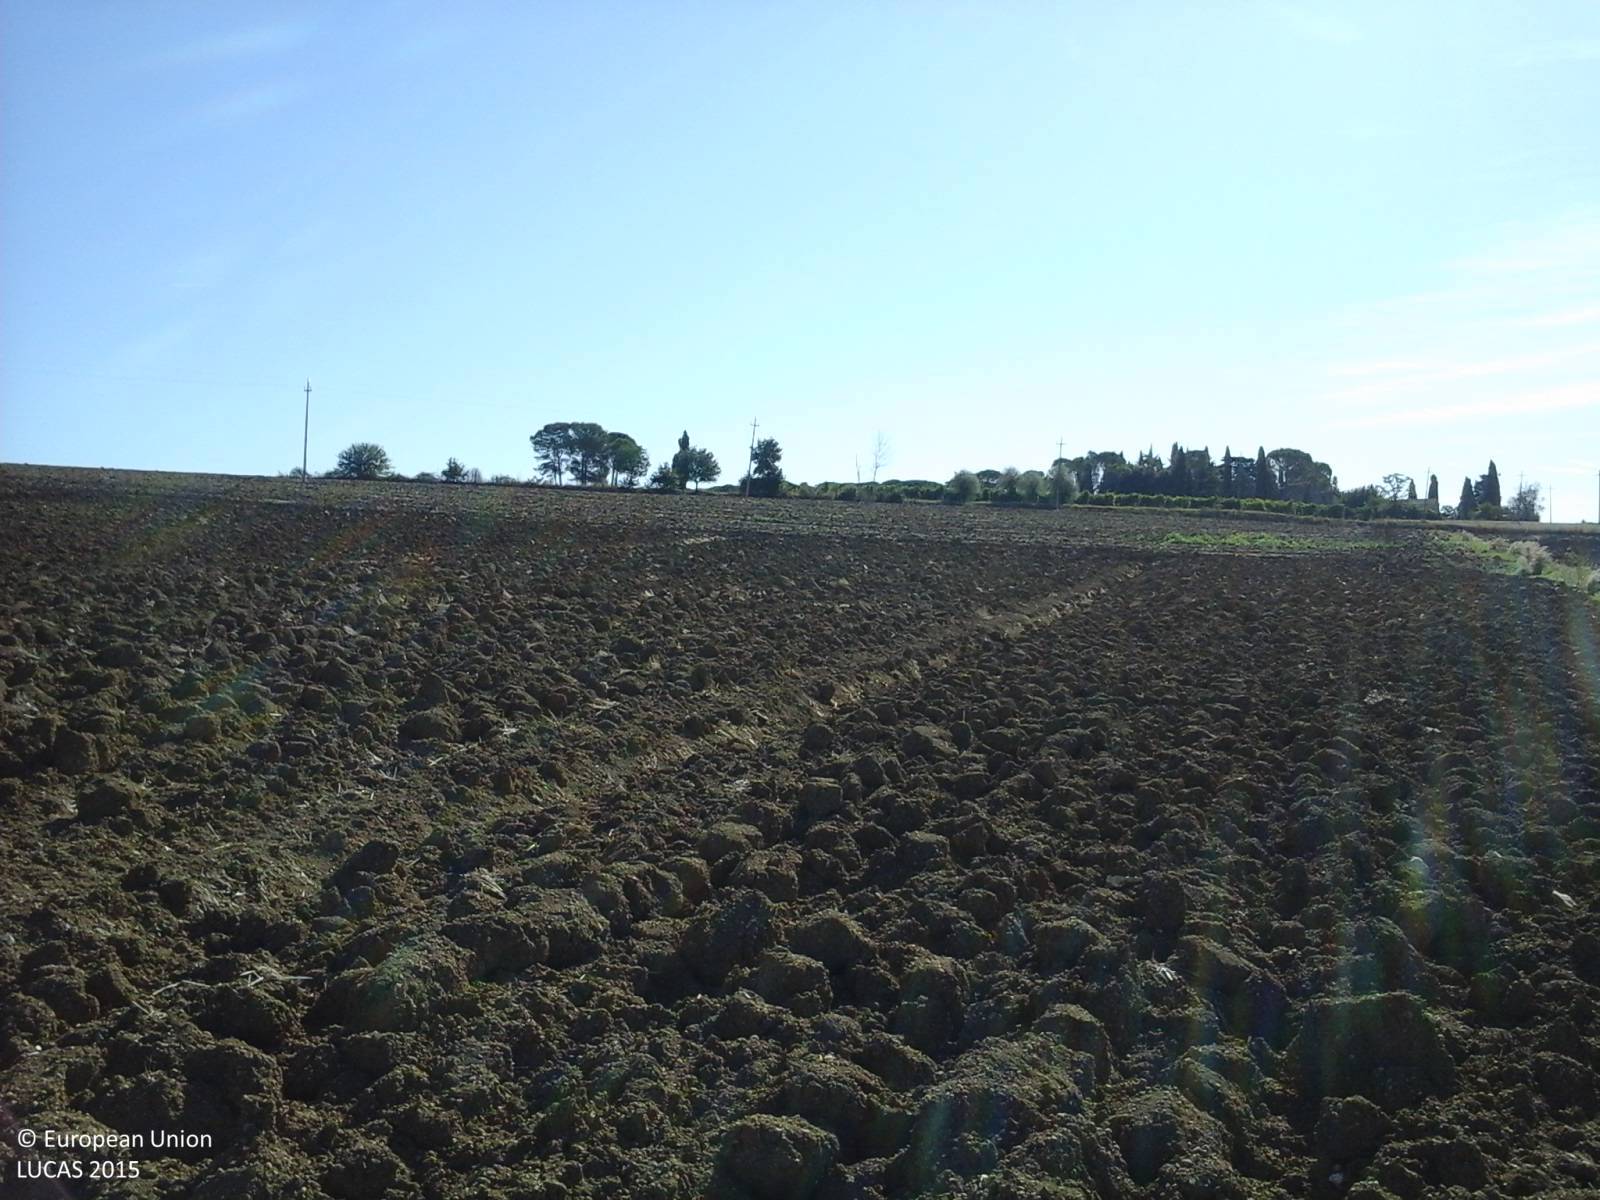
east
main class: Cropland
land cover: Common wheat
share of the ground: < 10 %
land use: Agriculture (excluding fallow land and kitchen gardens)
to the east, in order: Common wheat; Ditches and canals; Common wheat; Electric lines; Common wheat; Grass margins; Other bare soil
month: September
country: IT
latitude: 43.0251
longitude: 12.3125
